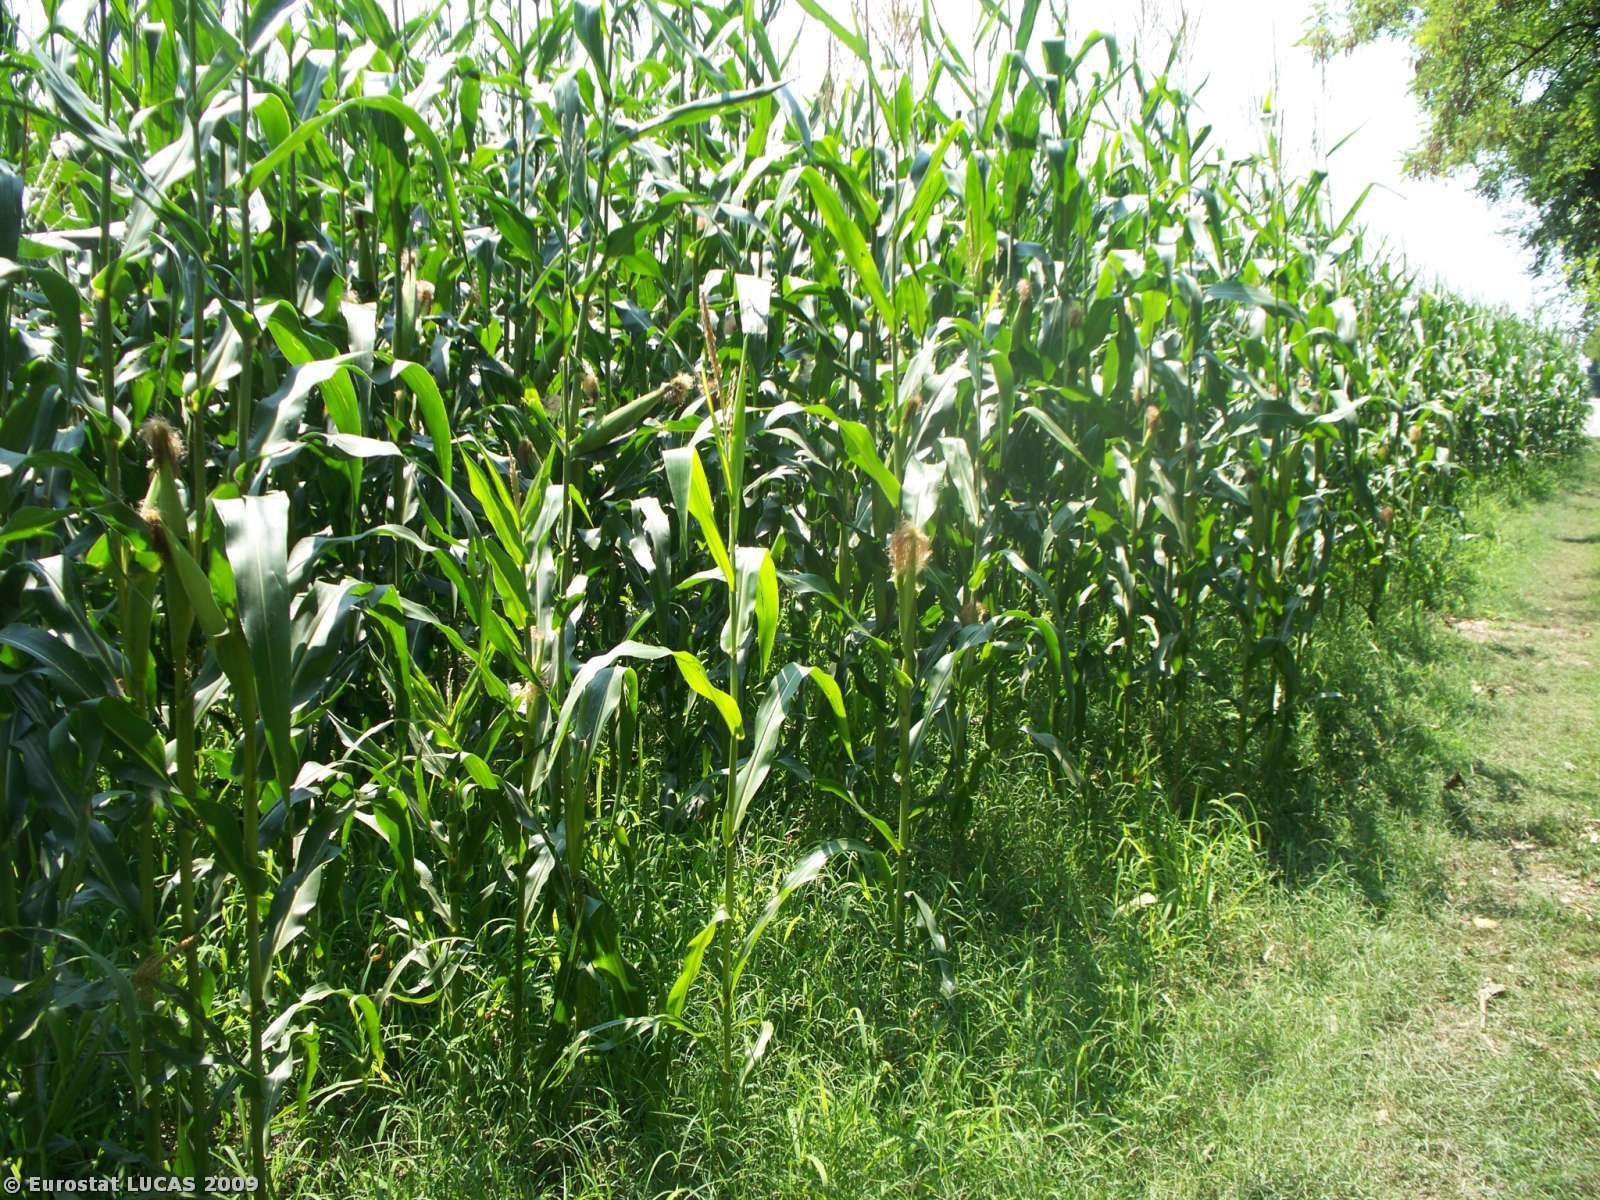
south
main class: Cropland
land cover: Maize
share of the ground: > 75 %
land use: Agriculture (excluding fallow land and kitchen gardens)
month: July
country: IT
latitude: 45.8910
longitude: 12.4324
